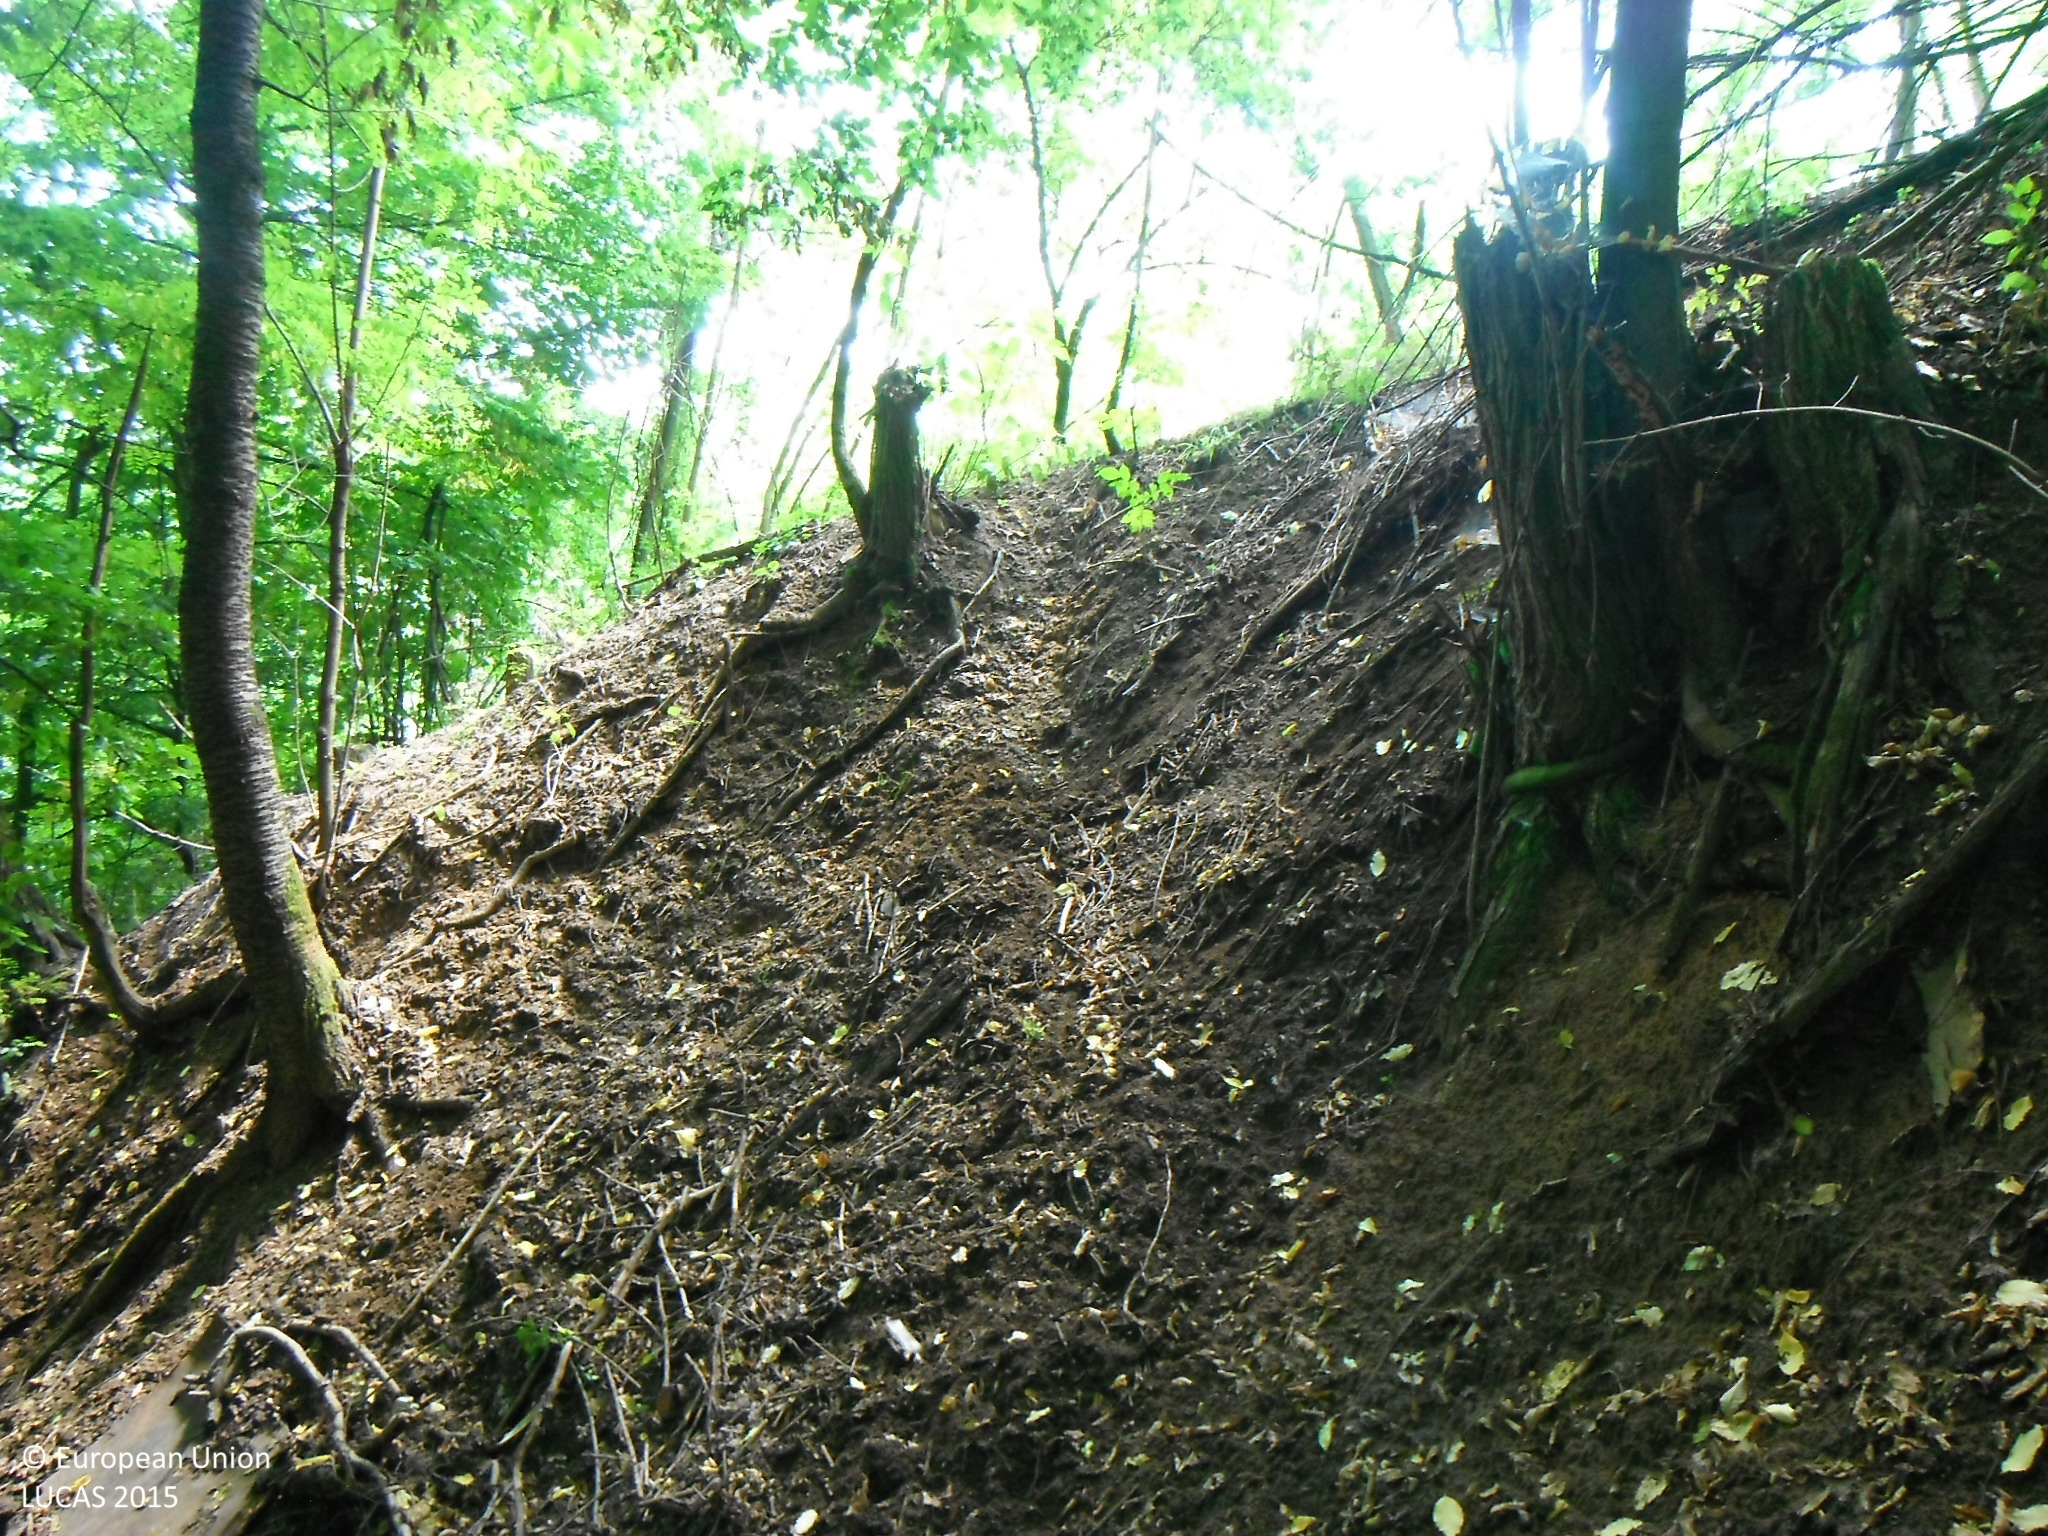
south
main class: Woodland
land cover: Broadleaved woodland
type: exotic forest
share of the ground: > 75 %
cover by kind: broadleaved forest trees 100 %
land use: Forestry
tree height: > 5 m
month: July
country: SK
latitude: 48.2054
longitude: 19.9723
